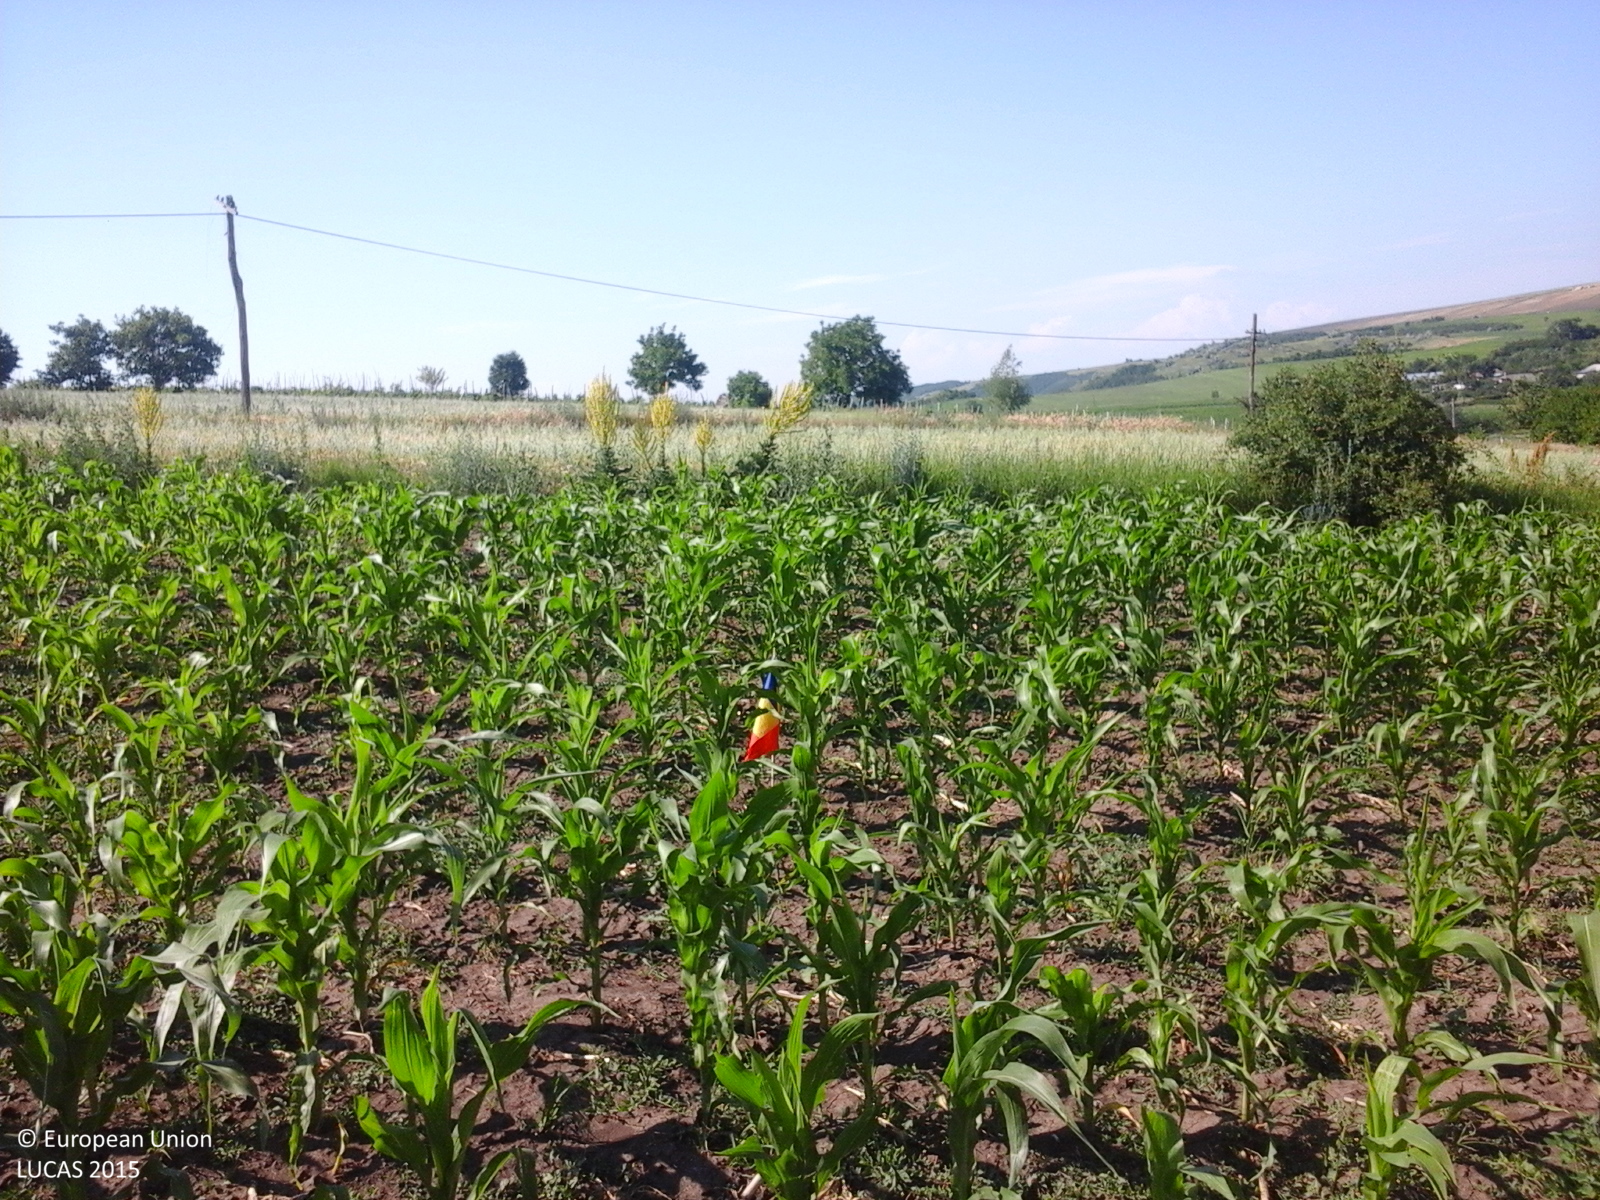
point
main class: Cropland
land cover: Maize
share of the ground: 25 - 50 %
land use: Agriculture (excluding fallow land and kitchen gardens)
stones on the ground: < 10 %
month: June
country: RO
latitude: 46.7837
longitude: 27.9813
